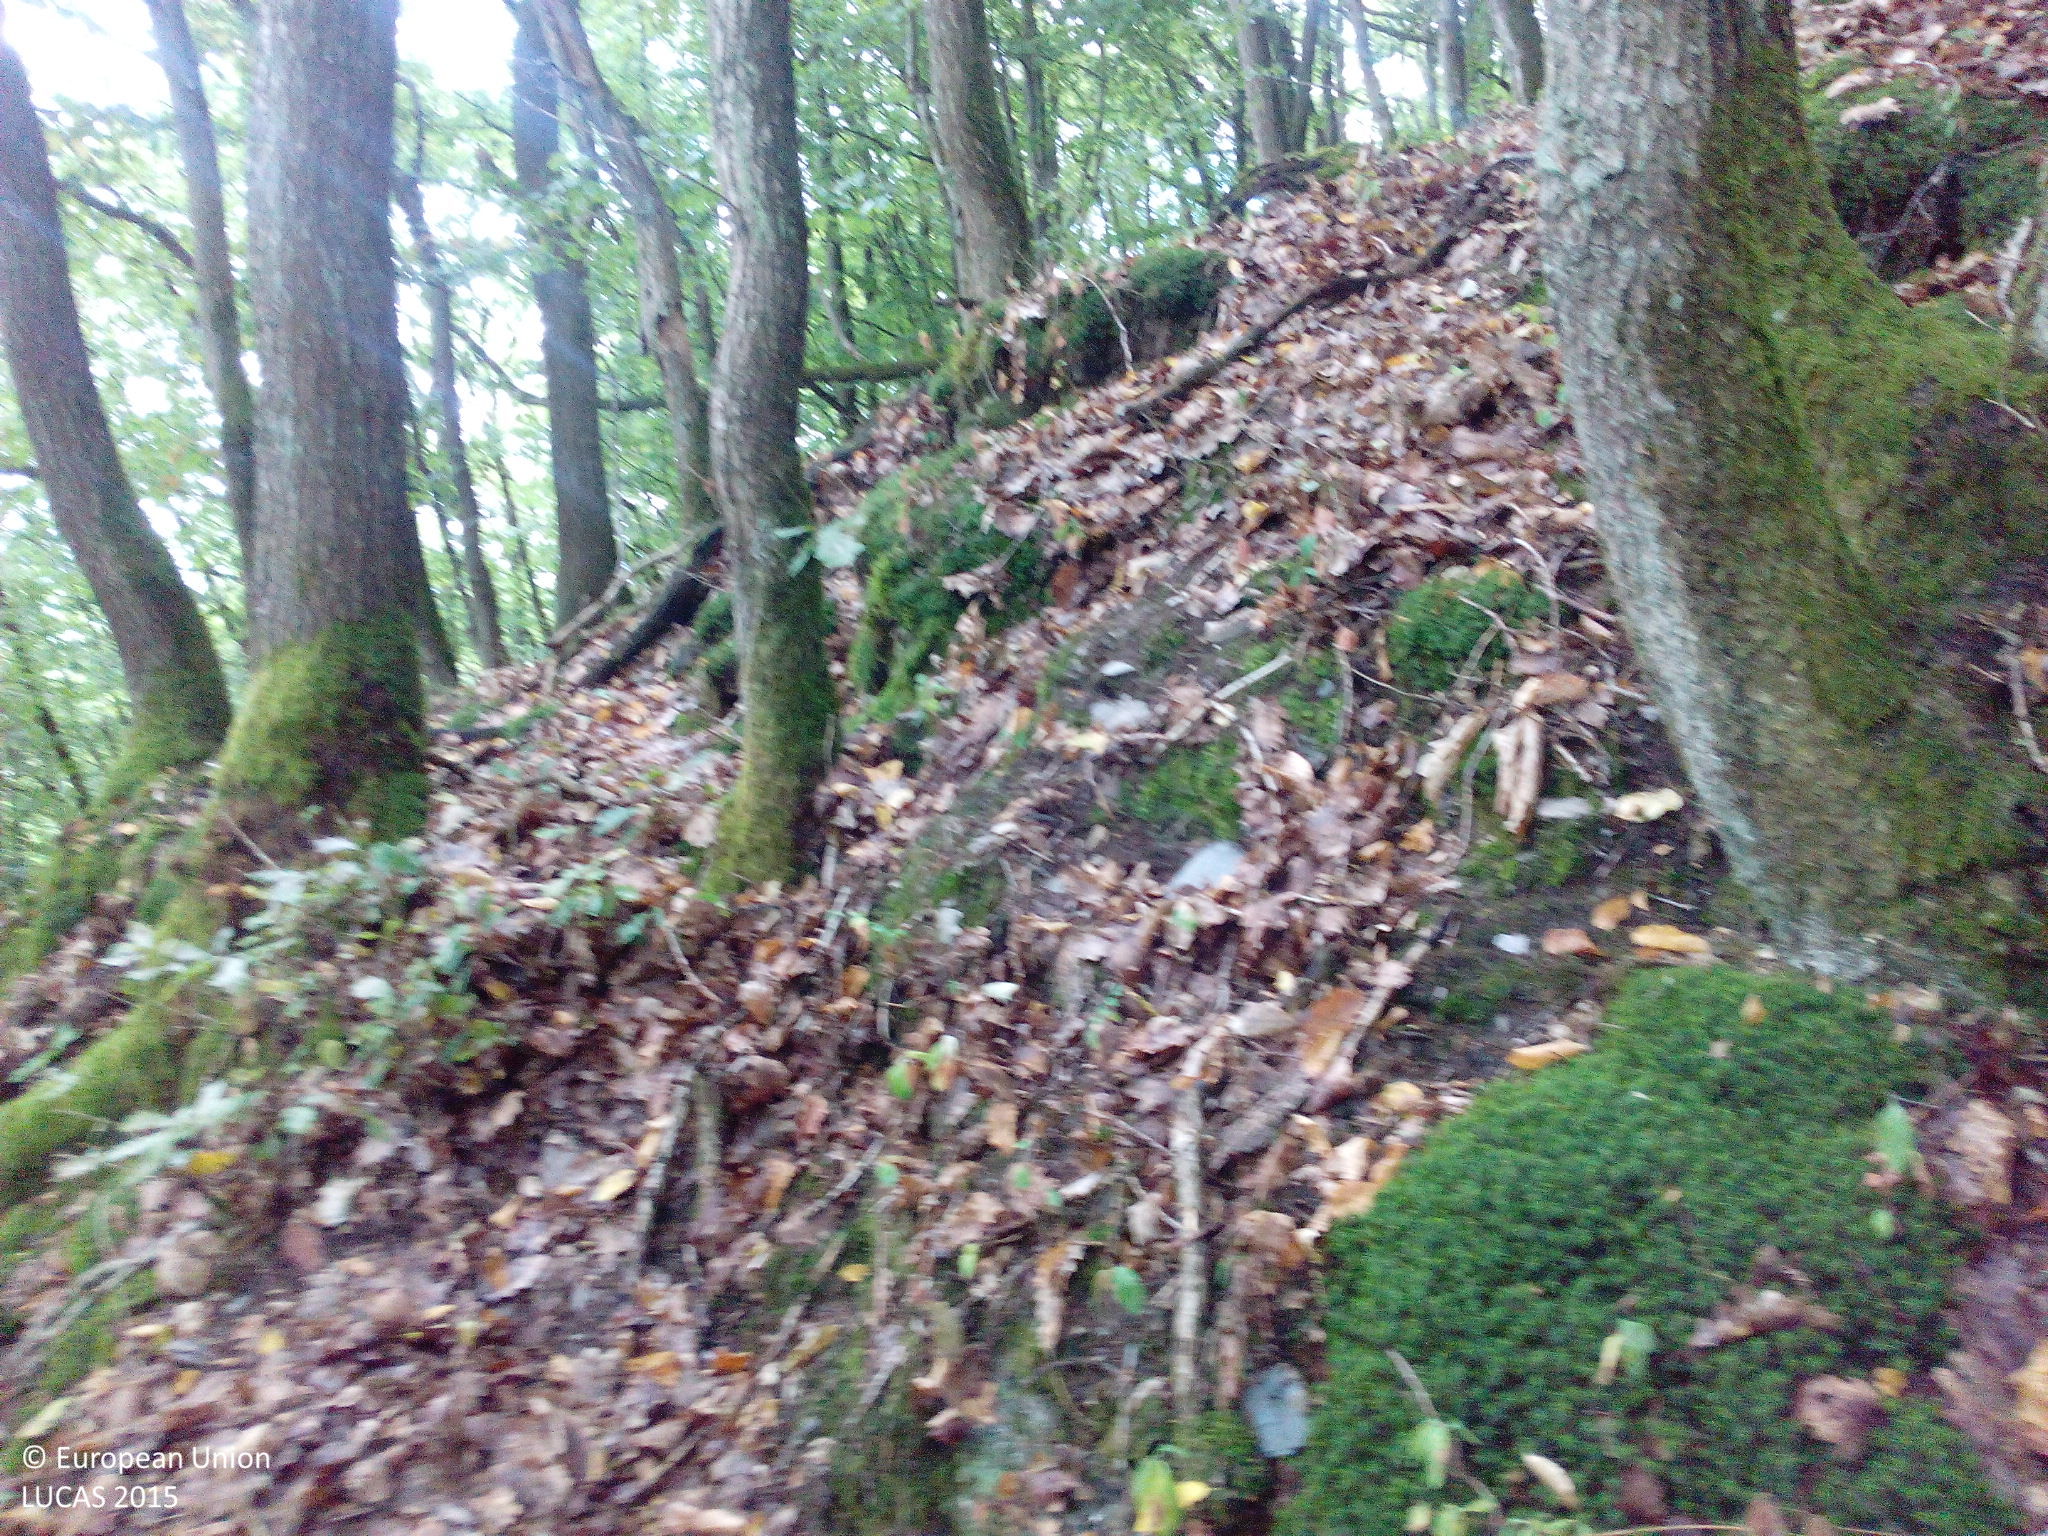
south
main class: Woodland
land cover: Broadleaved woodland
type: mesophytic deciduous forest
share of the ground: > 75 %
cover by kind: broadleaved forest trees 100 %
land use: Forestry
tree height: > 5 m
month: July
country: DE
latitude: 49.9858
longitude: 7.1131
